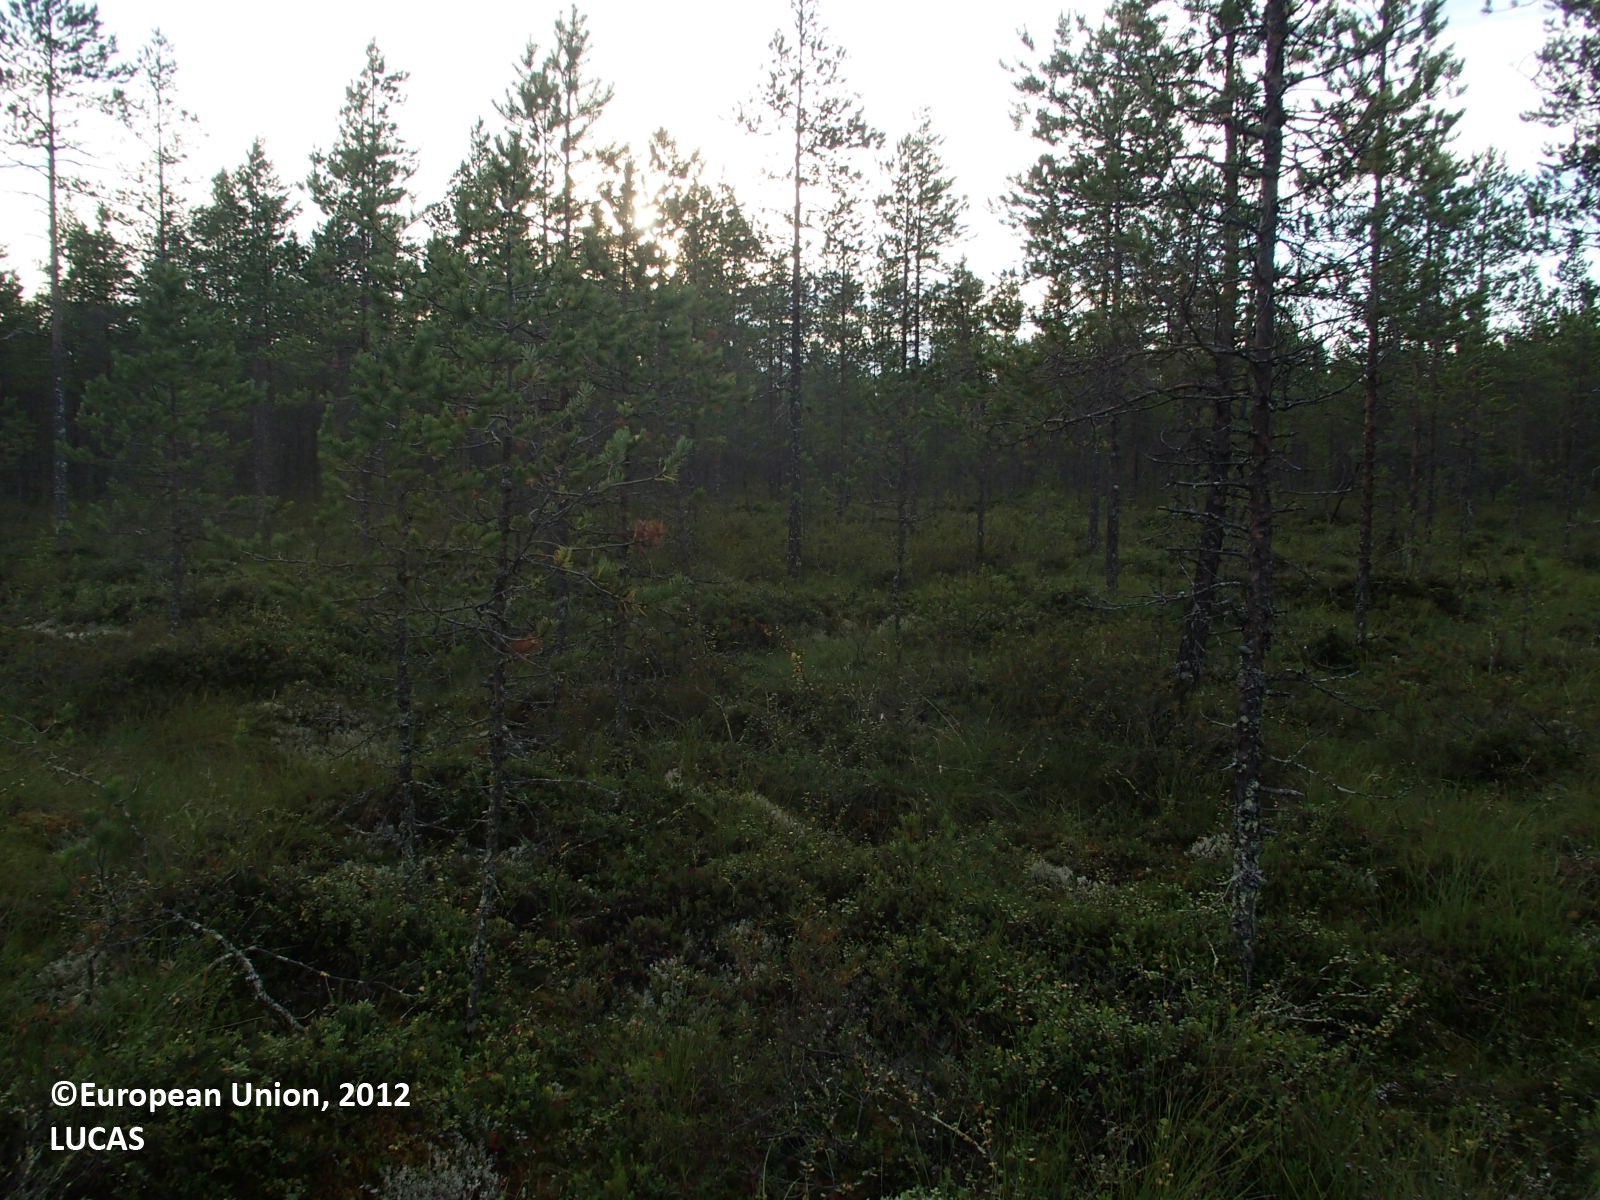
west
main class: Woodland
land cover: Pine dominated coniferous woodland
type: boreal forest
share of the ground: 10 - 25 %
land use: Forestry
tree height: > 5 m
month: August
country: FI
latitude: 64.1011
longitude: 26.1361
